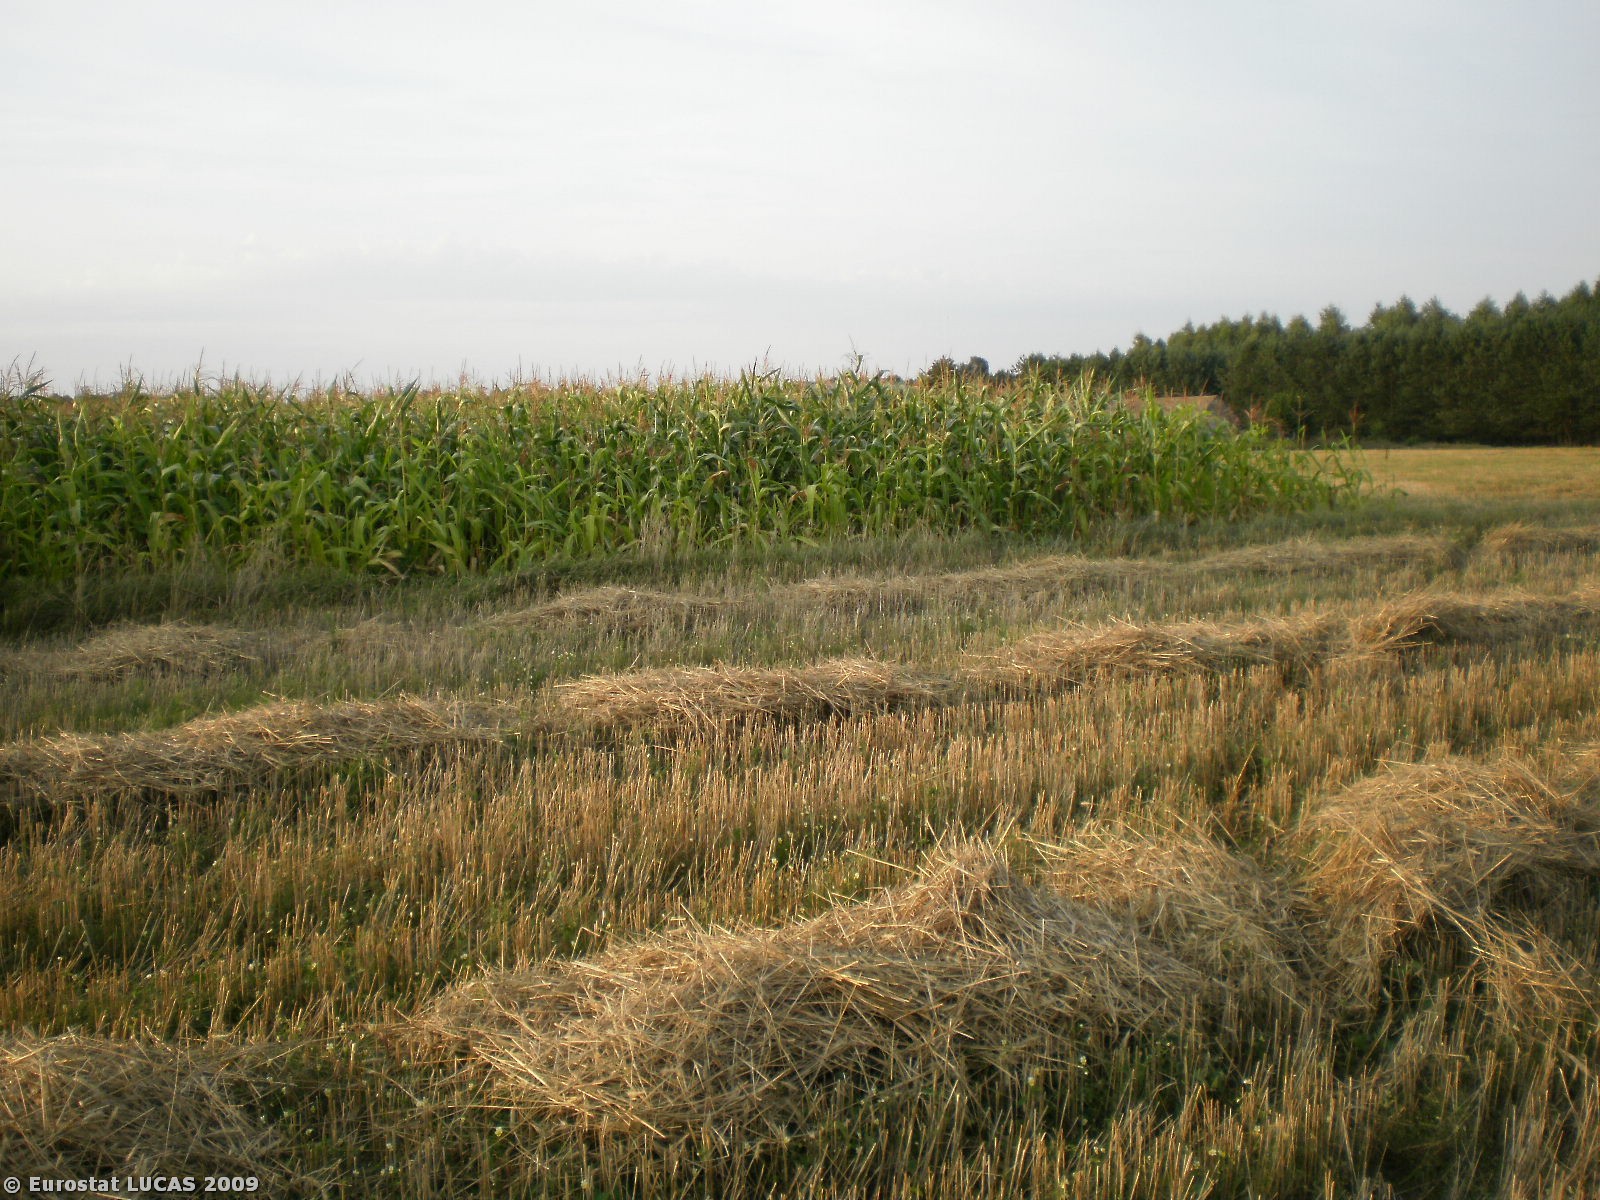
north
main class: Cropland
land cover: Rye
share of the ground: < 10 %
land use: Agriculture (excluding fallow land and kitchen gardens)
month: August
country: PL
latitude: 53.0504
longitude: 21.8861
